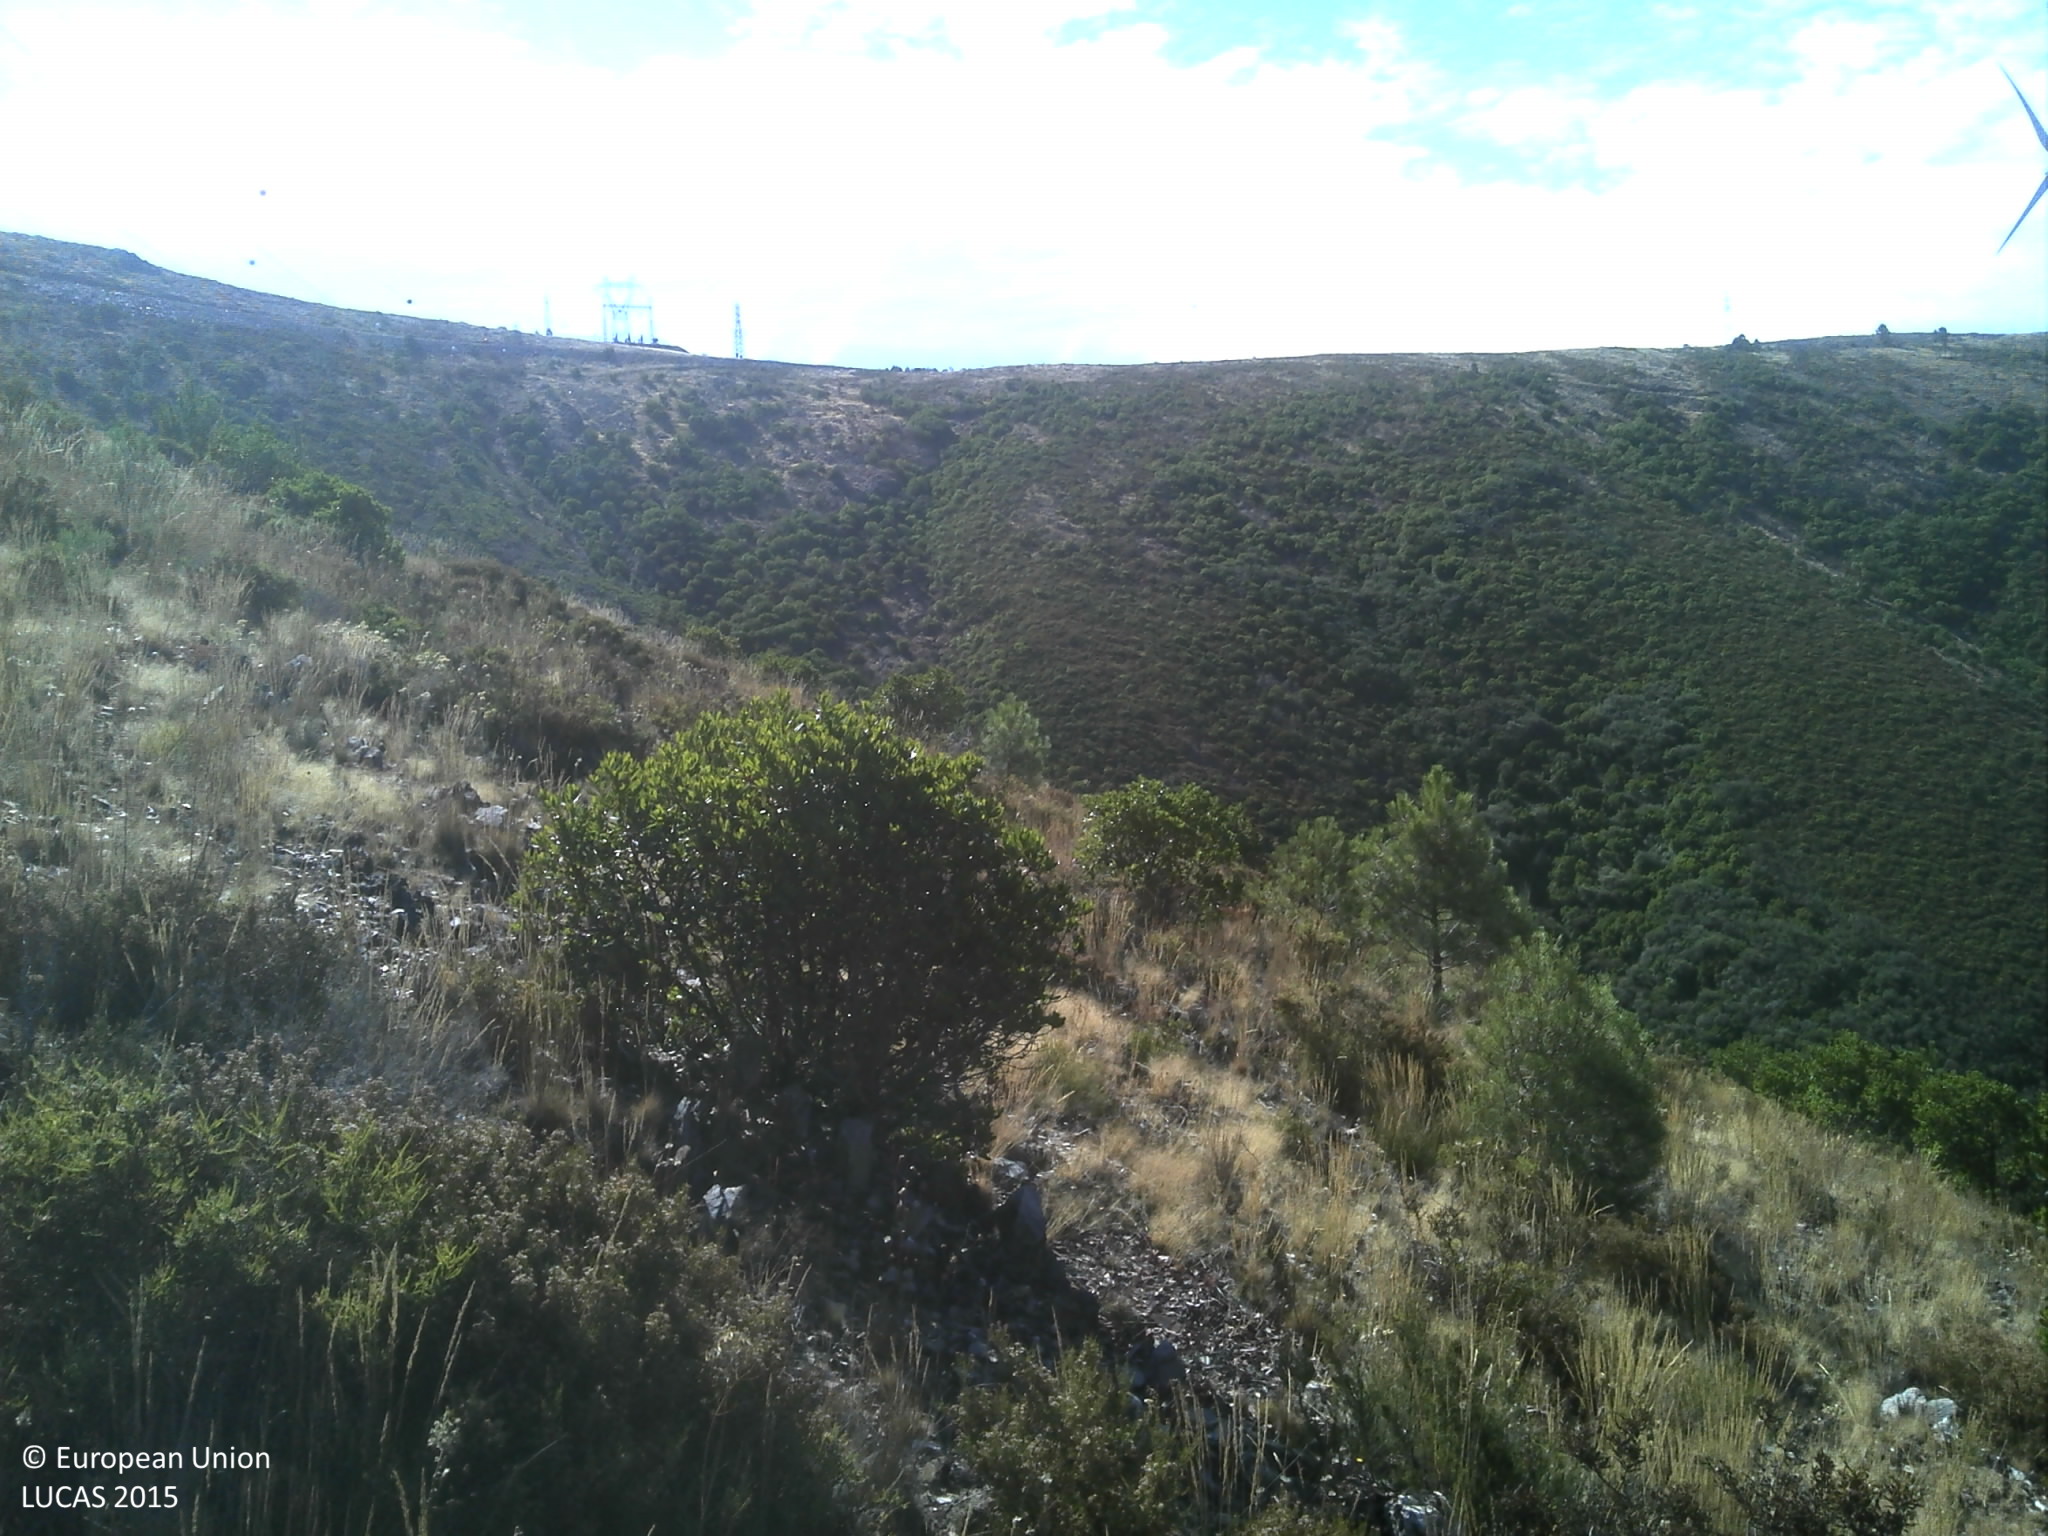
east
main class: Shrubland
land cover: Shrubland without tree cover
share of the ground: > 75 %
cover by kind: shrubs 75 %, unconsolidated bare surface 25 %
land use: Semi-natural and natural areas not in use
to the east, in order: Shrubland without tree cover; Electric lines; Shrubland without tree cover; Pine dominated coniferous woodland; Shrubland with sparse tree cover
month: July
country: PT
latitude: 40.1357
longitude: -7.9197
